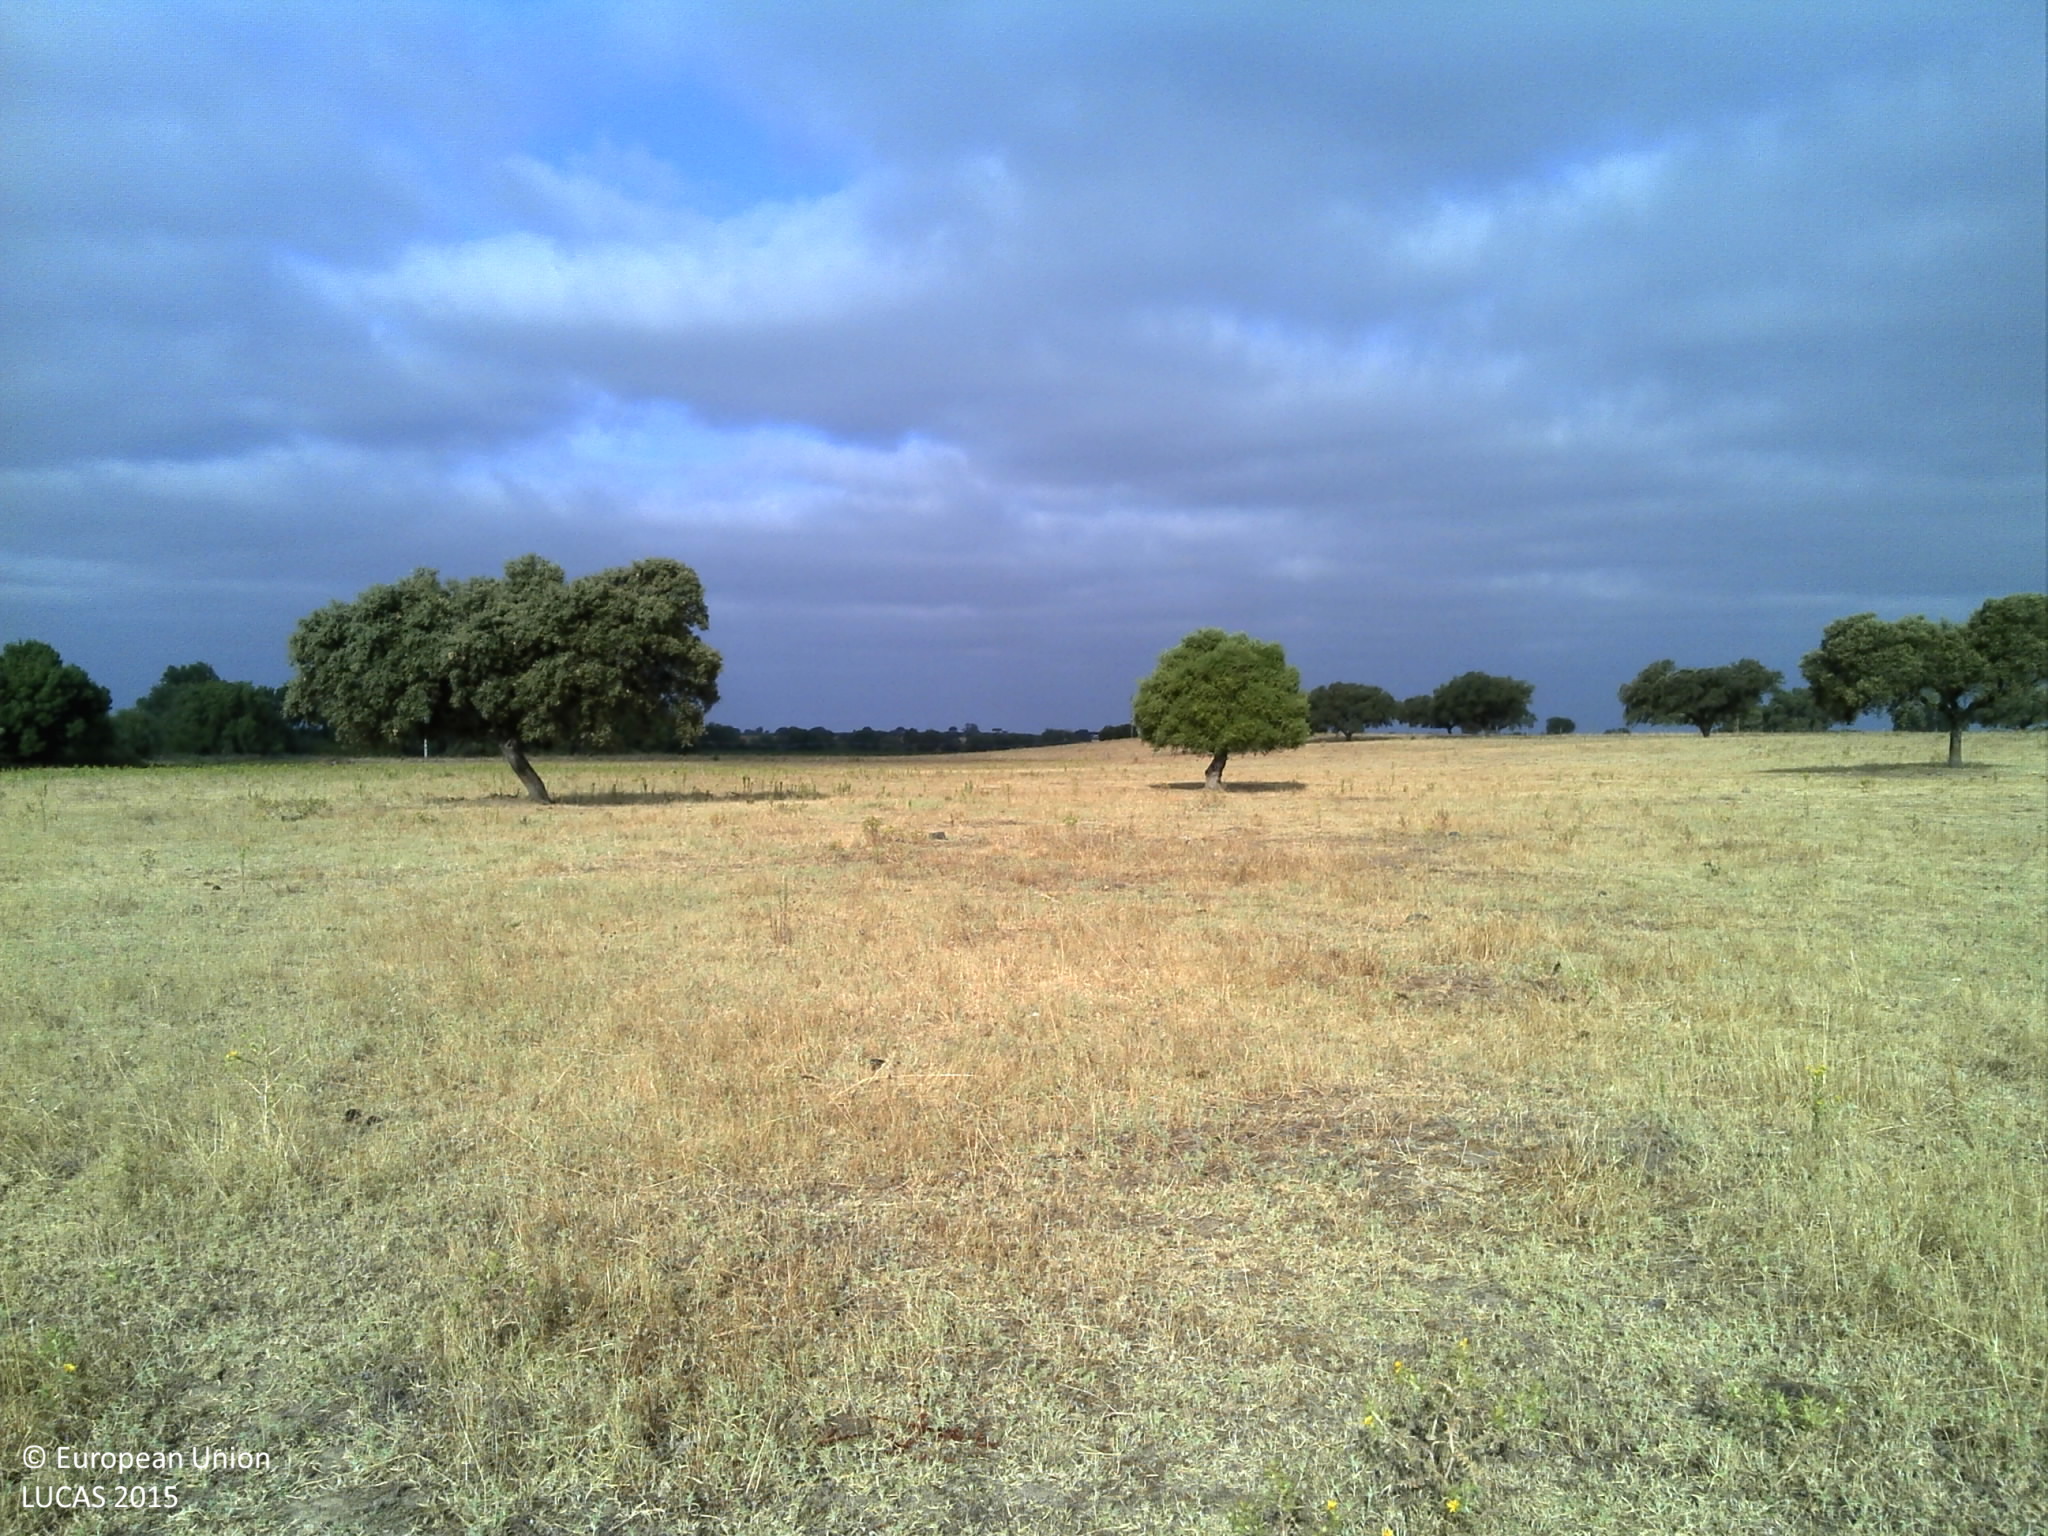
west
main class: Grassland
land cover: Grassland without tree/shrub cover
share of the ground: 10 - 25 %
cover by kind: unconsolidated bare surface 90 %, herbaceous plants 10 %
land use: Agriculture (excluding fallow land and kitchen gardens)
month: June
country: PT
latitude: 38.2120
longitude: -7.9298
